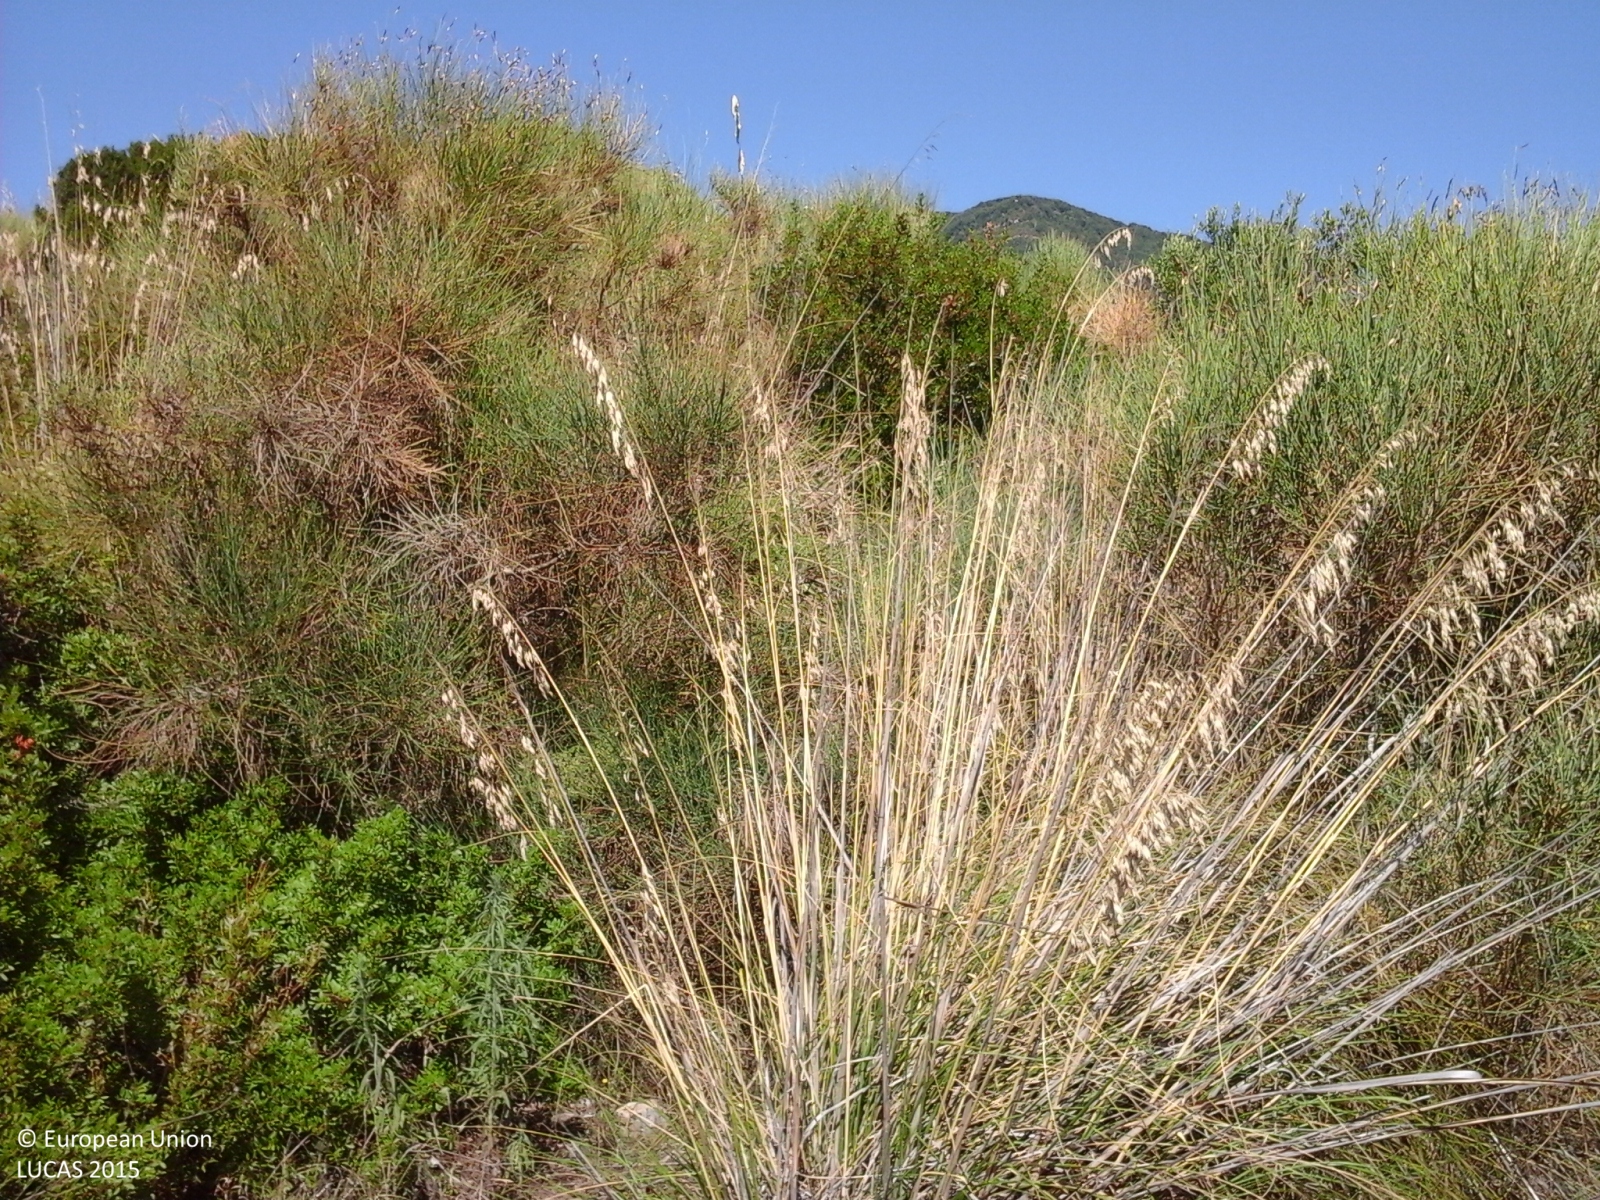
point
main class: Shrubland
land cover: Shrubland with sparse tree cover
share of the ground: > 75 %
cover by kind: shrubs 80 %, herbaceous plants 15 %, broadleaved forest trees 5 %
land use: Semi-natural and natural areas not in use
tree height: < 5 m
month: August
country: IT
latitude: 40.2259
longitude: 15.0894
